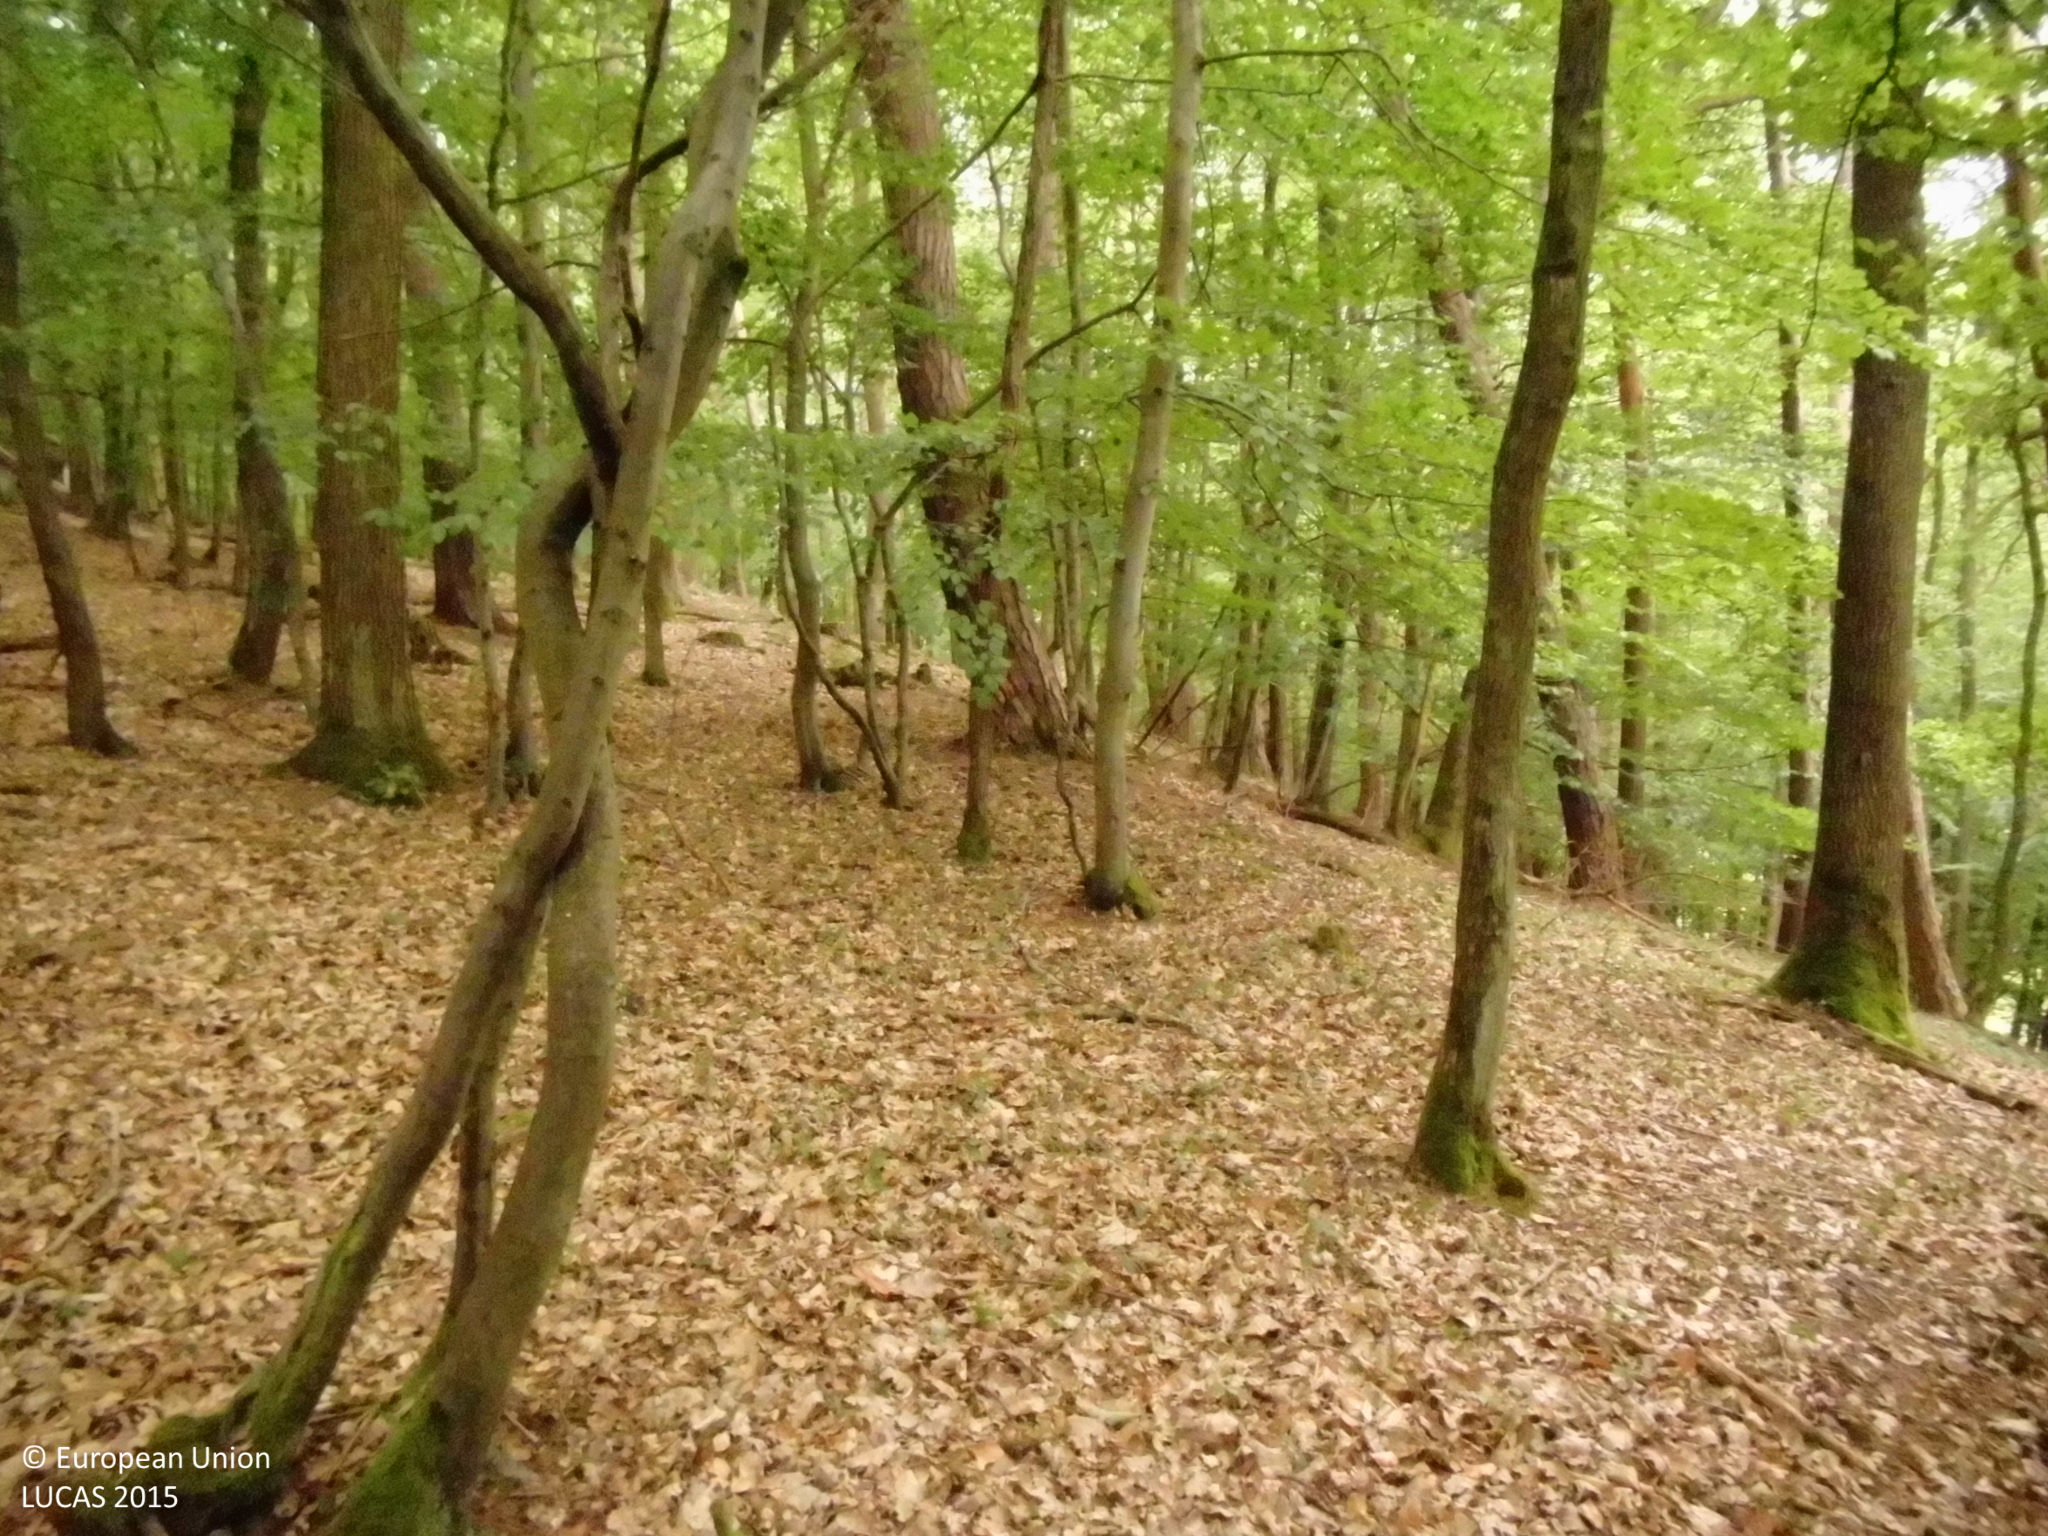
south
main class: Woodland
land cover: Pine dominated mixed woodland
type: hemiboreal forest and nemoral coniferous forest and mixed broadleaved-coniferous forest
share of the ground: > 75 %
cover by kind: broadleaved forest trees 70 %, coniferous forest trees 30 %
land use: Forestry
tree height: > 5 m
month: July
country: DE
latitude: 50.4437
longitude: 8.4655
